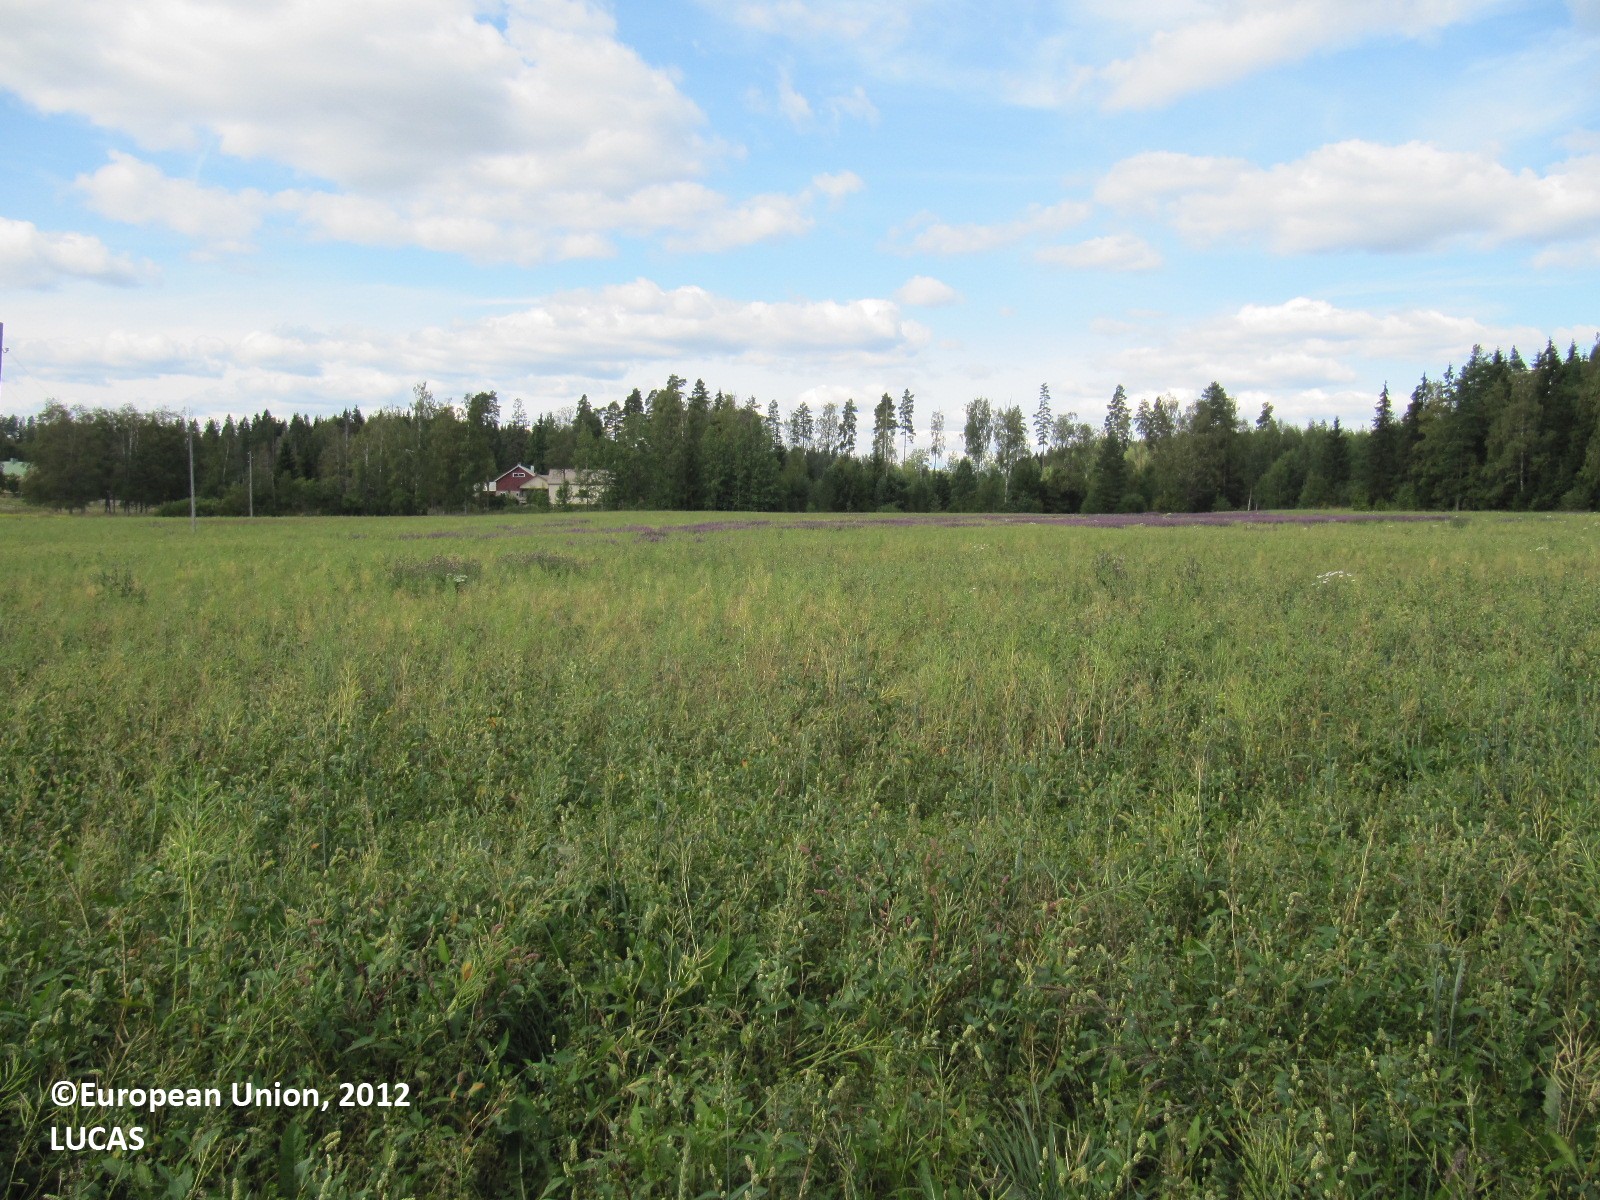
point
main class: Cropland
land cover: Dry pulses
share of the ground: > 75 %
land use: Agriculture (excluding fallow land and kitchen gardens)
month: August
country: FI
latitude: 60.3919
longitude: 24.3849
